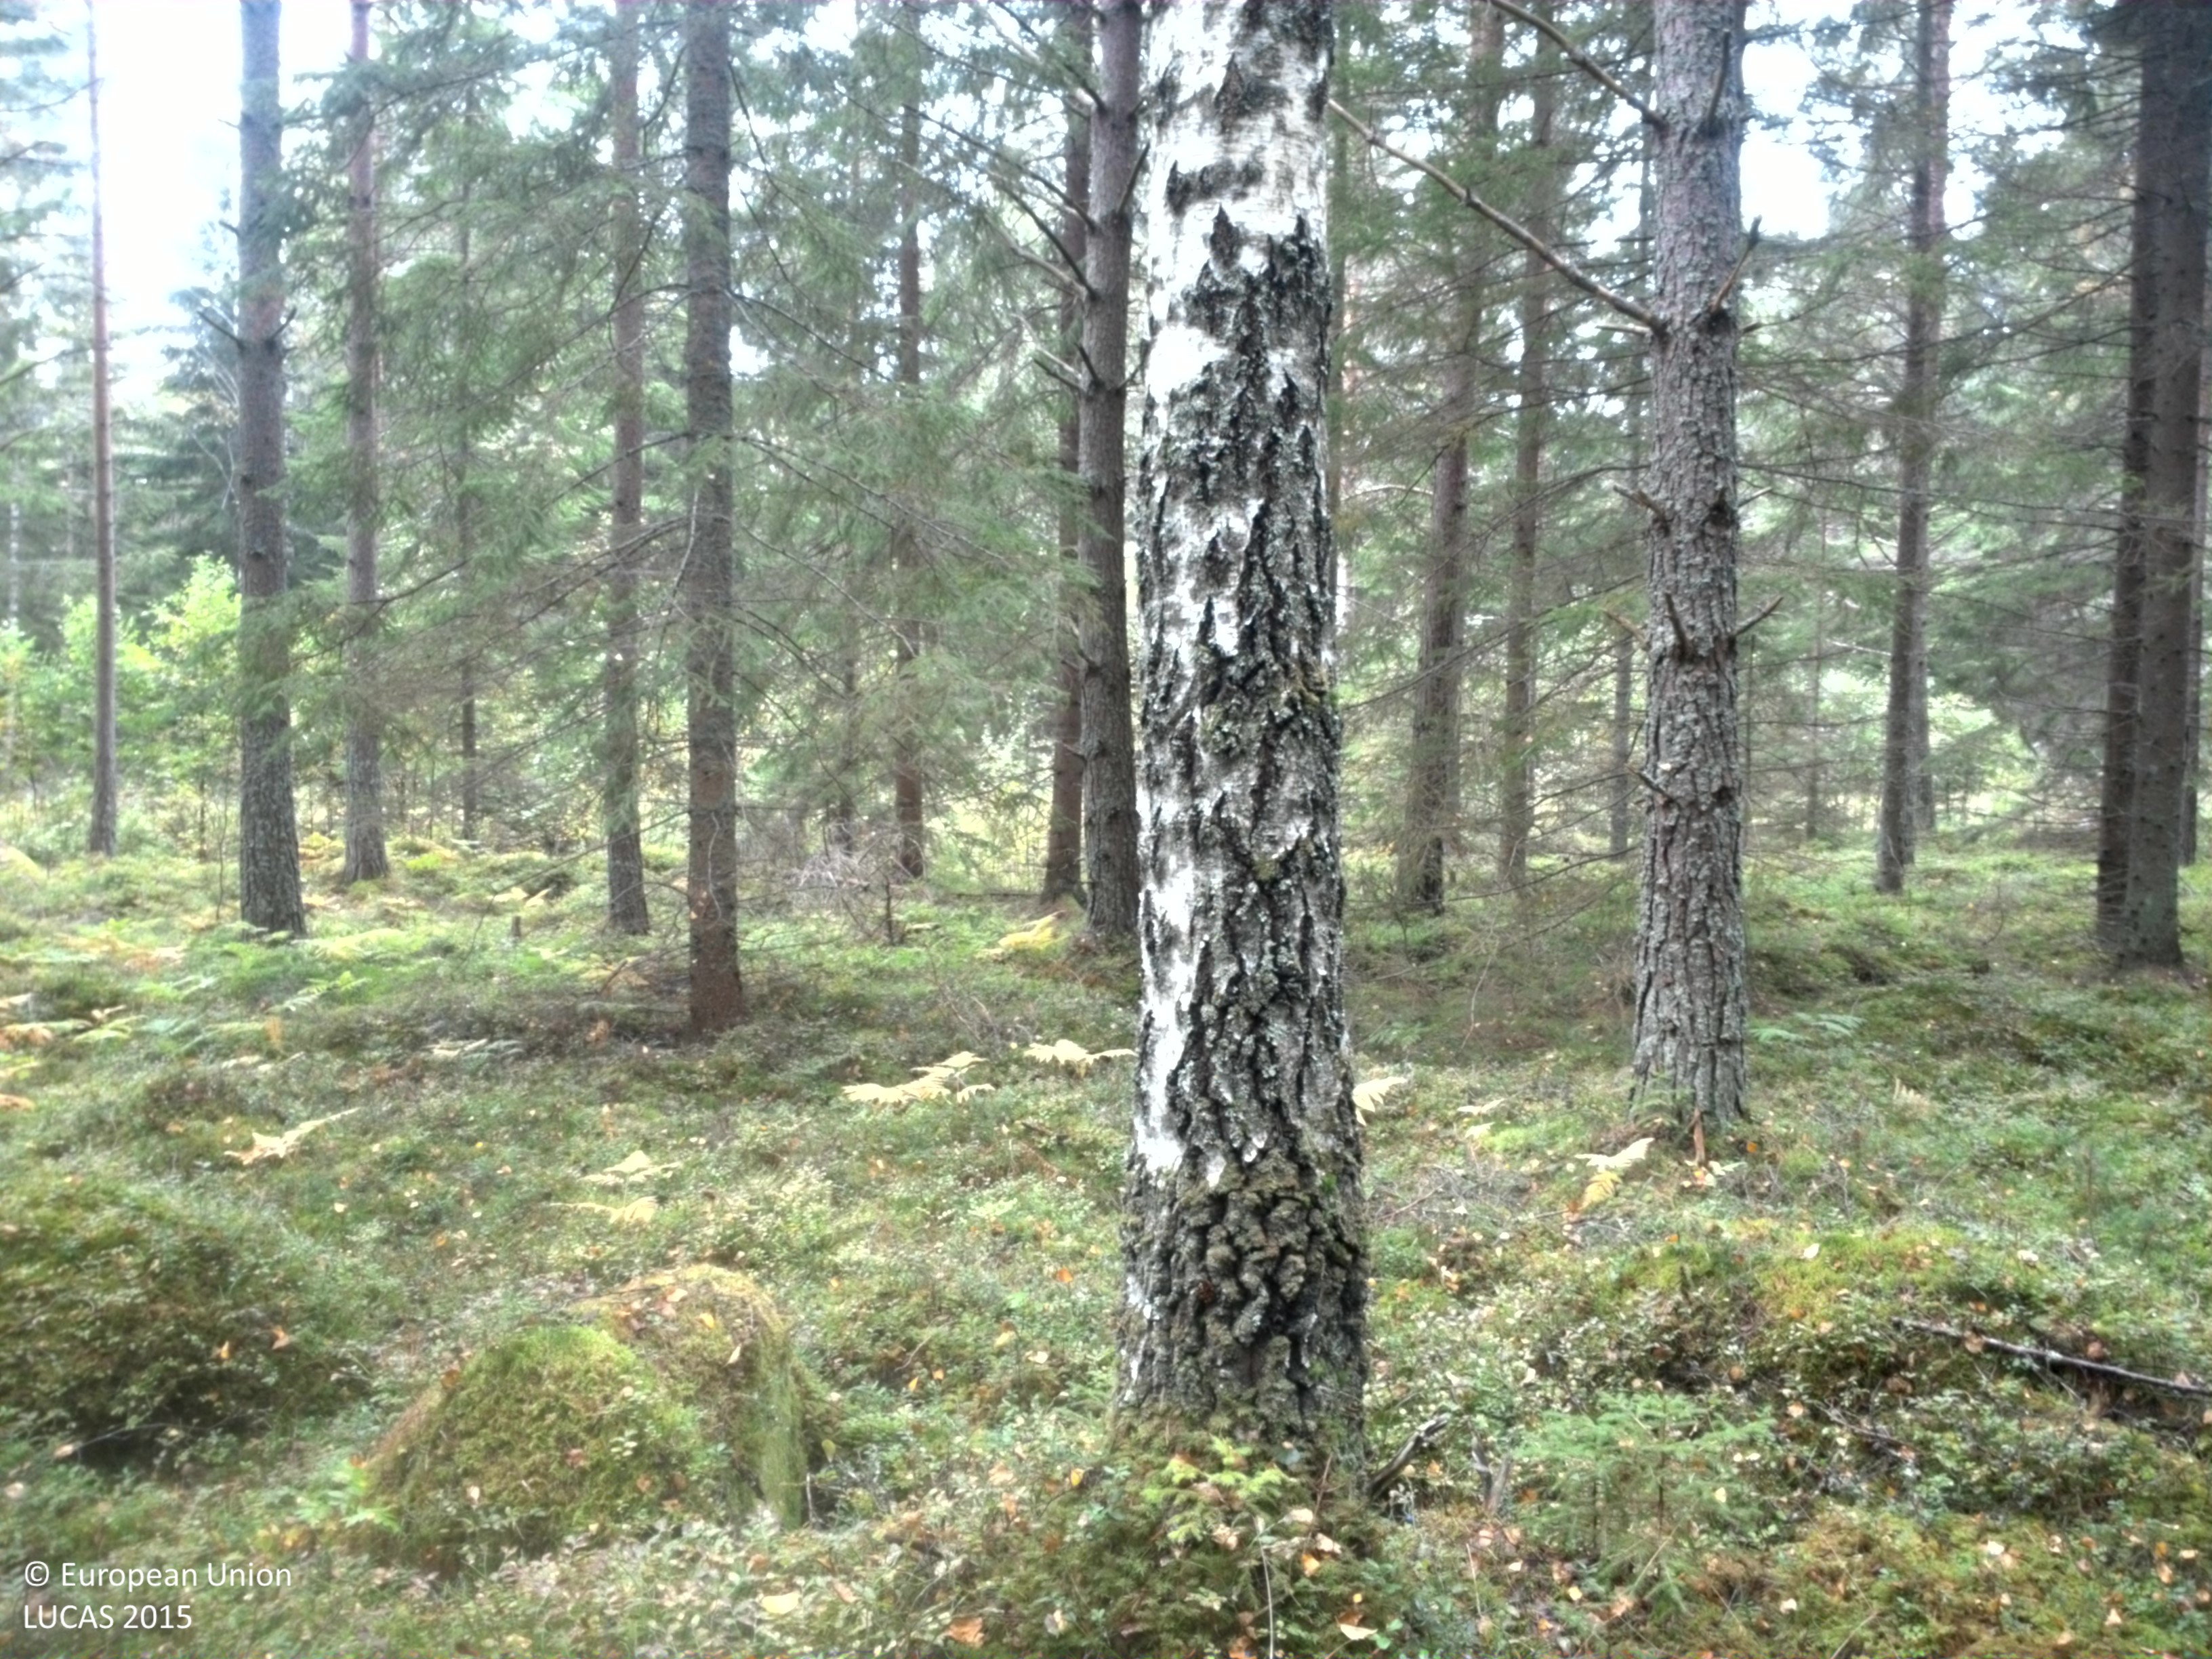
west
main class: Woodland
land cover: Other coniferous woodland
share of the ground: 25 - 50 %
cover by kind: coniferous forest trees 40 %, shrubs 25 %, lichens and mosses 20 %, broadleaved forest trees 10 %, herbaceous plants 5 %
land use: Forestry
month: September
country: SE
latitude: 58.8426
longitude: 14.0650
